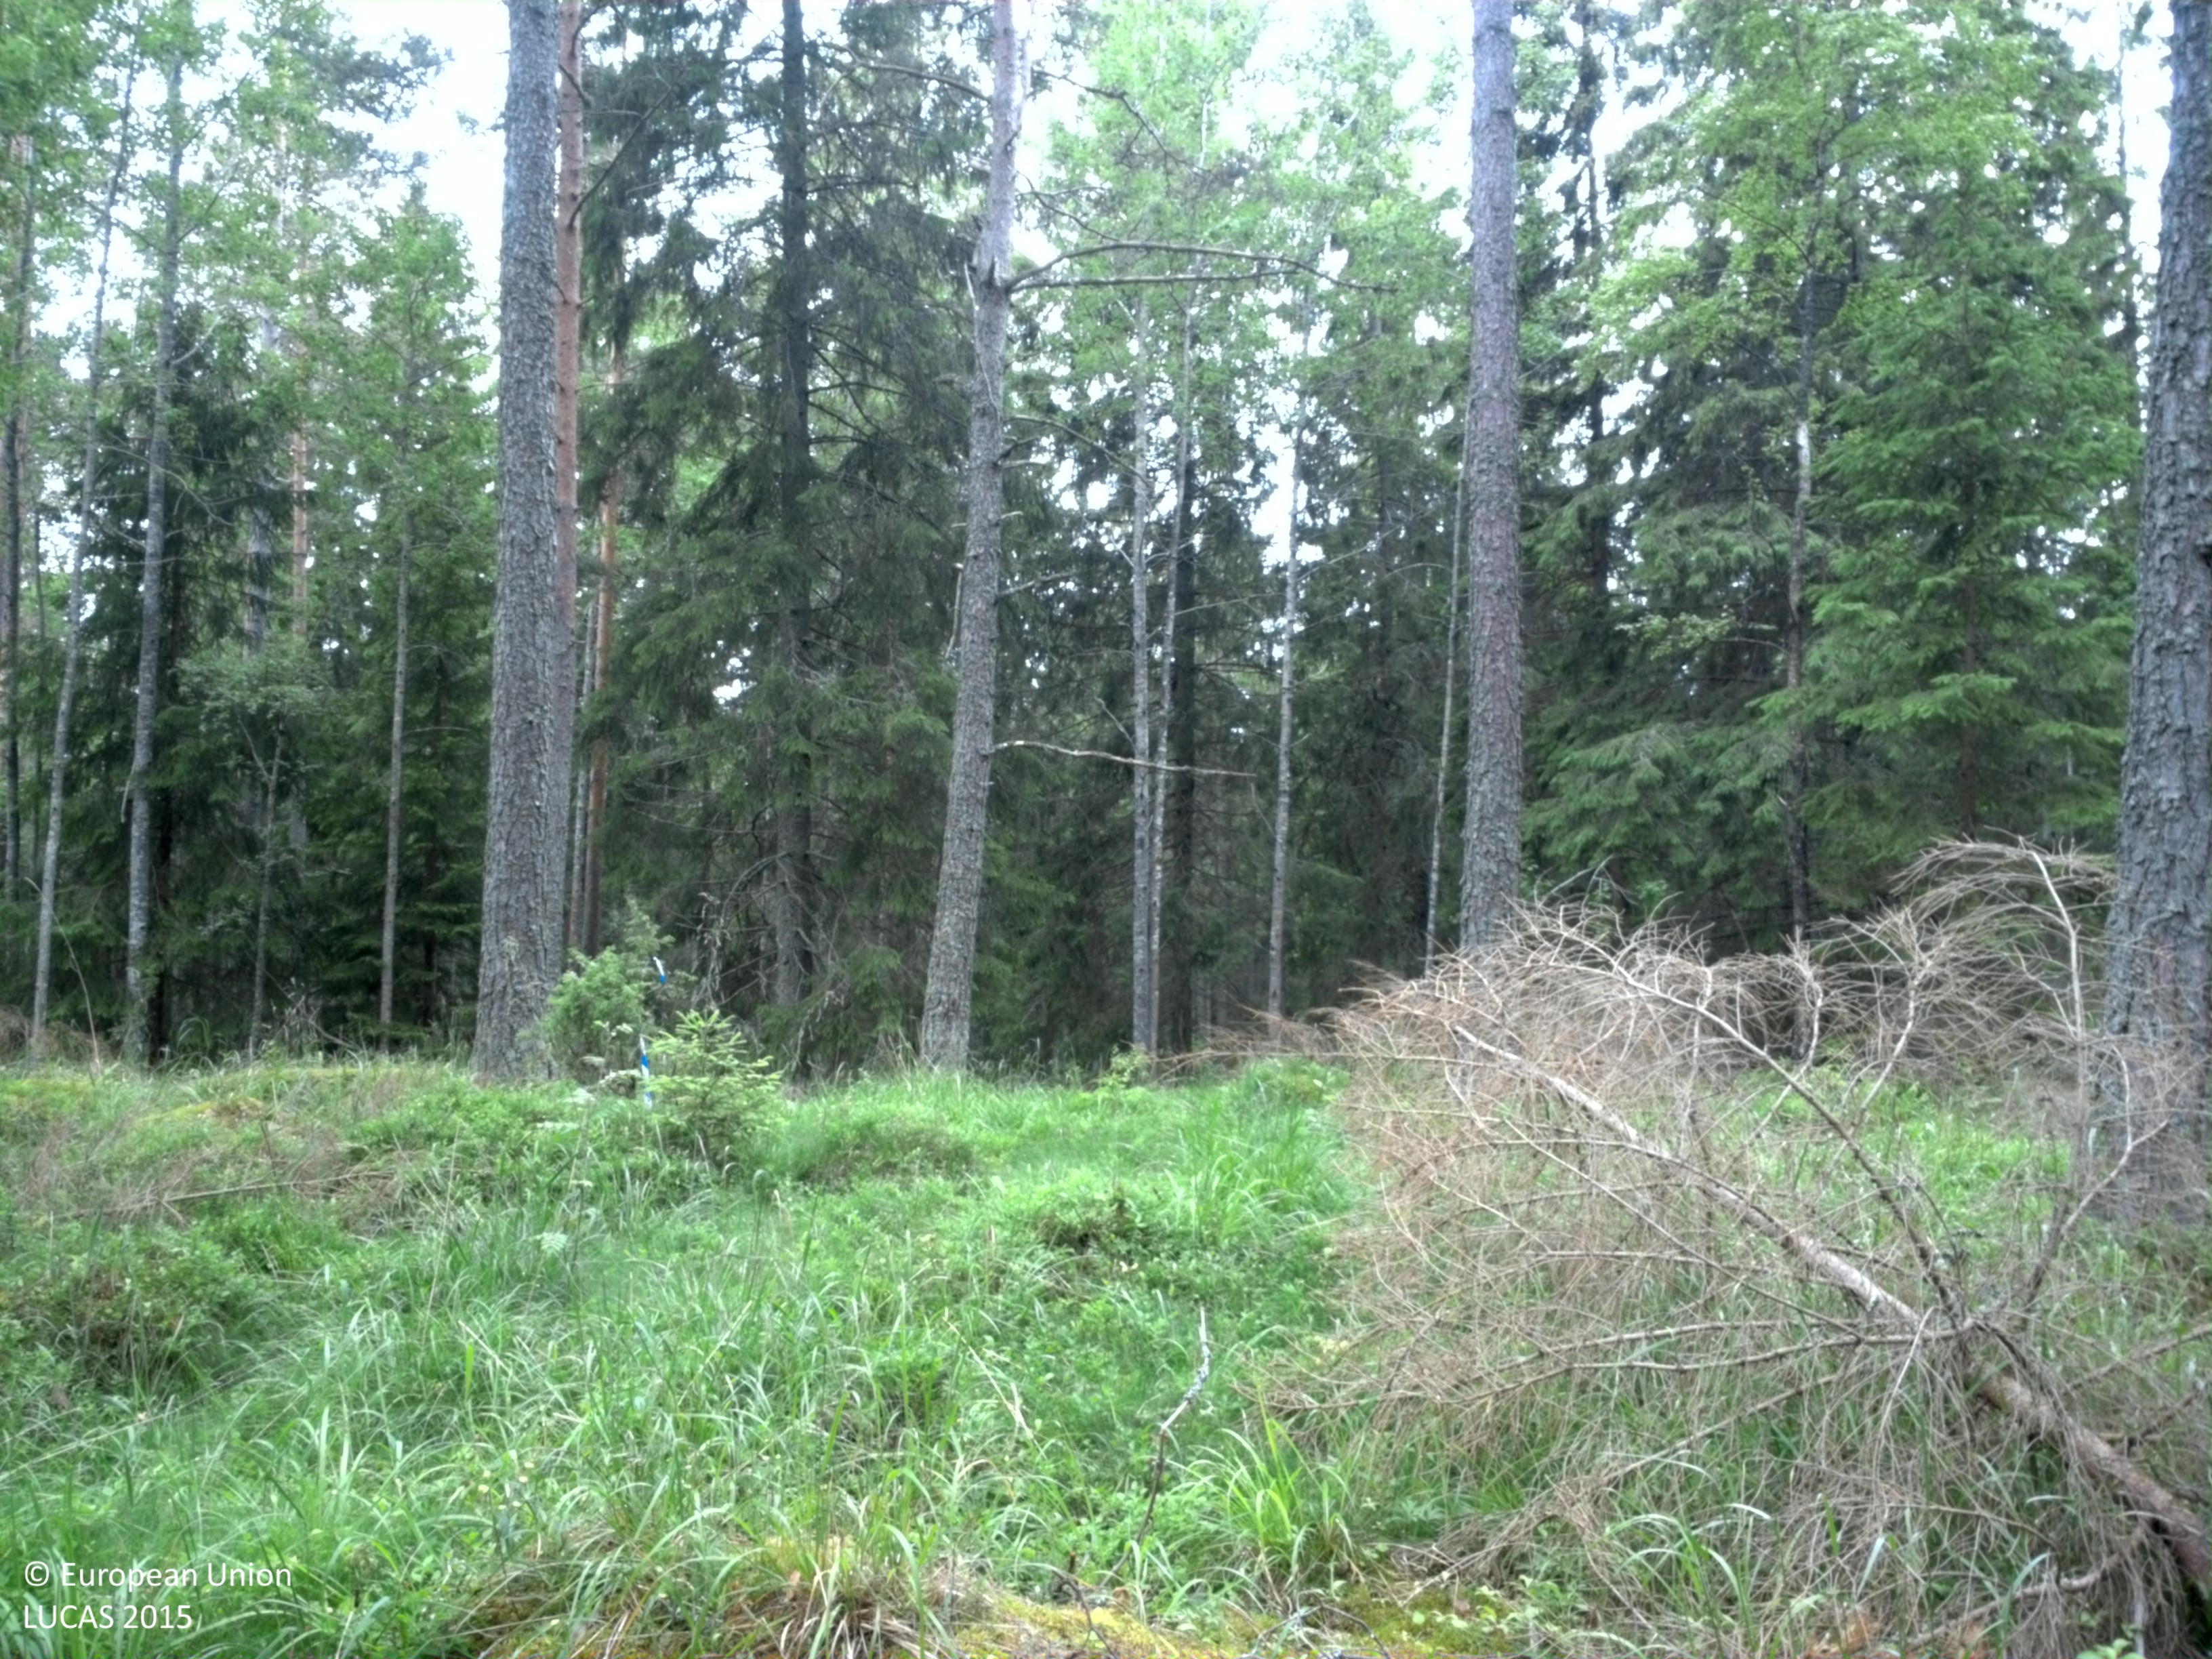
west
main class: Woodland
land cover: Other coniferous woodland
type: boreal forest
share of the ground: 50 - 75 %
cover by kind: coniferous forest trees 55 %, herbaceous plants 20 %, lichens and mosses 20 %, broadleaved forest trees 5 %
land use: Forestry
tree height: > 5 m
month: June
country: SE
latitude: 59.7105
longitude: 18.7280
